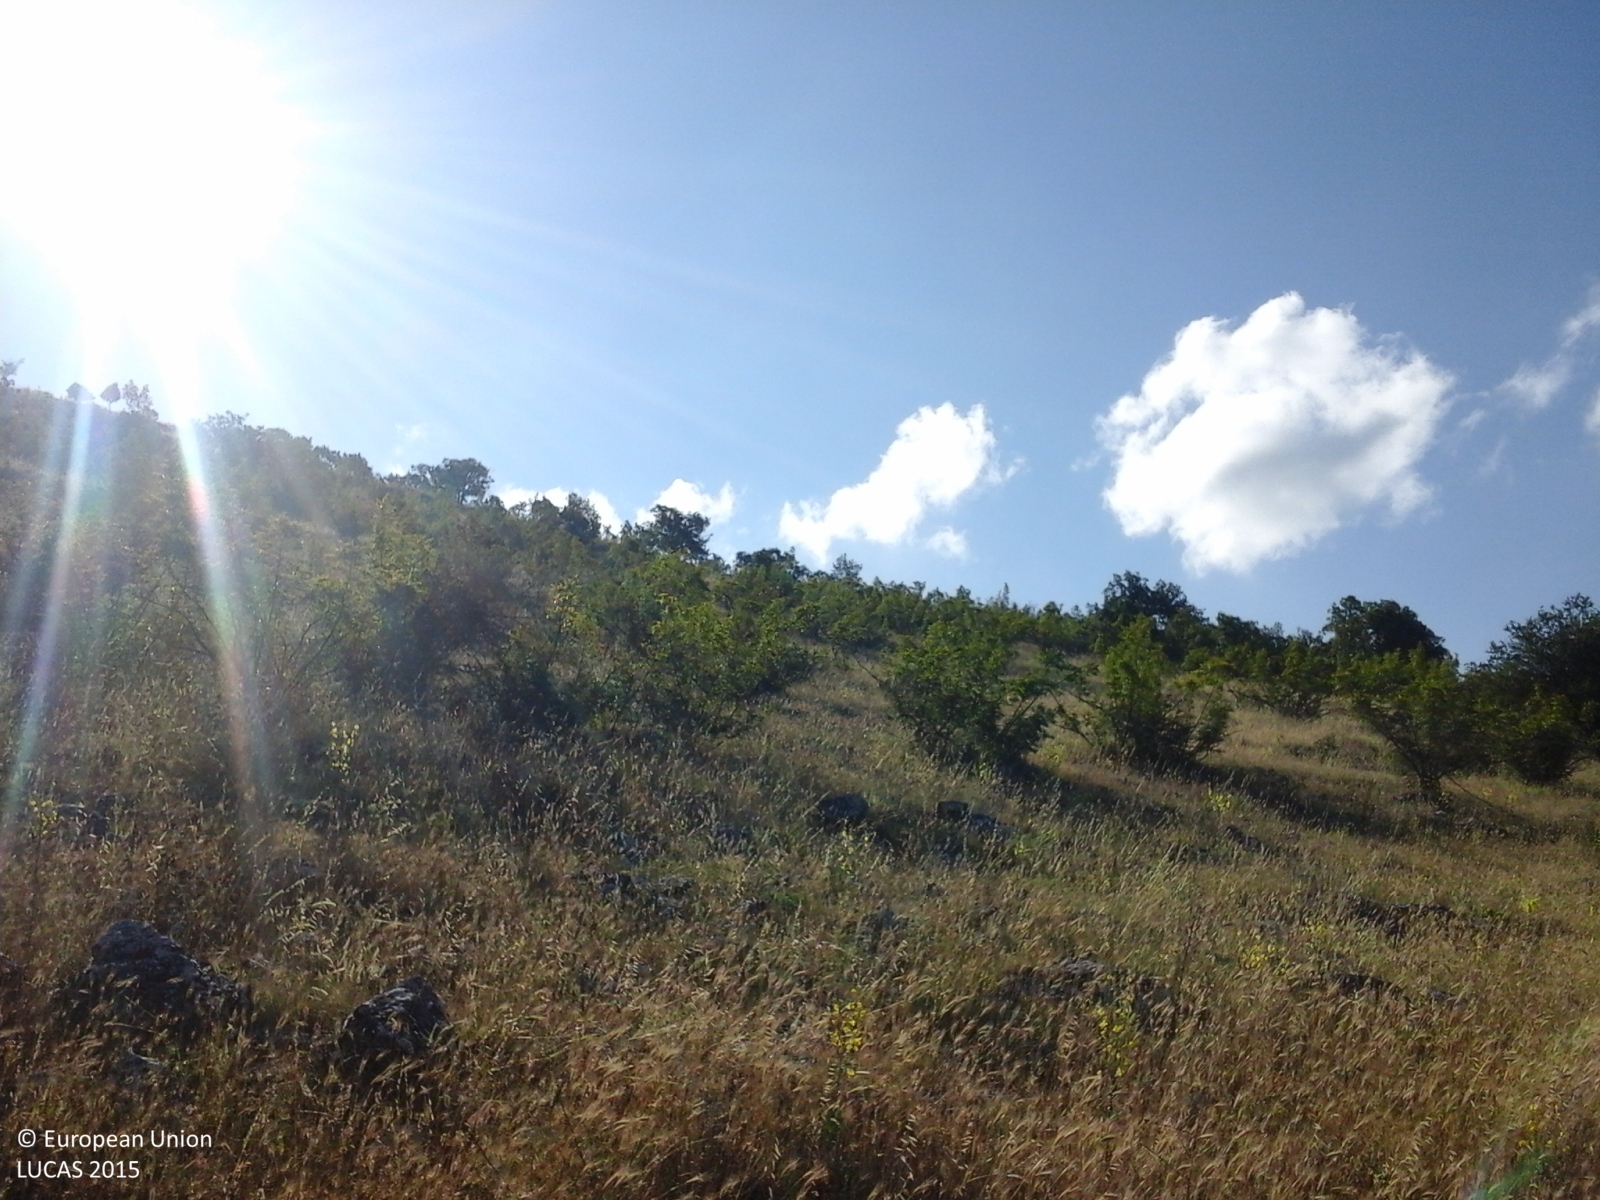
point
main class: Shrubland
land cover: Shrubland with sparse tree cover
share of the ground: 50 - 75 %
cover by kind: shrubs 50 %, herbaceous plants 35 %, unconsolidated bare surface 10 %, broadleaved forest trees 5 %
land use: Semi-natural and natural areas not in use
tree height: < 5 m
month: June
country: GR
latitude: 40.4466
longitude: 21.3440
